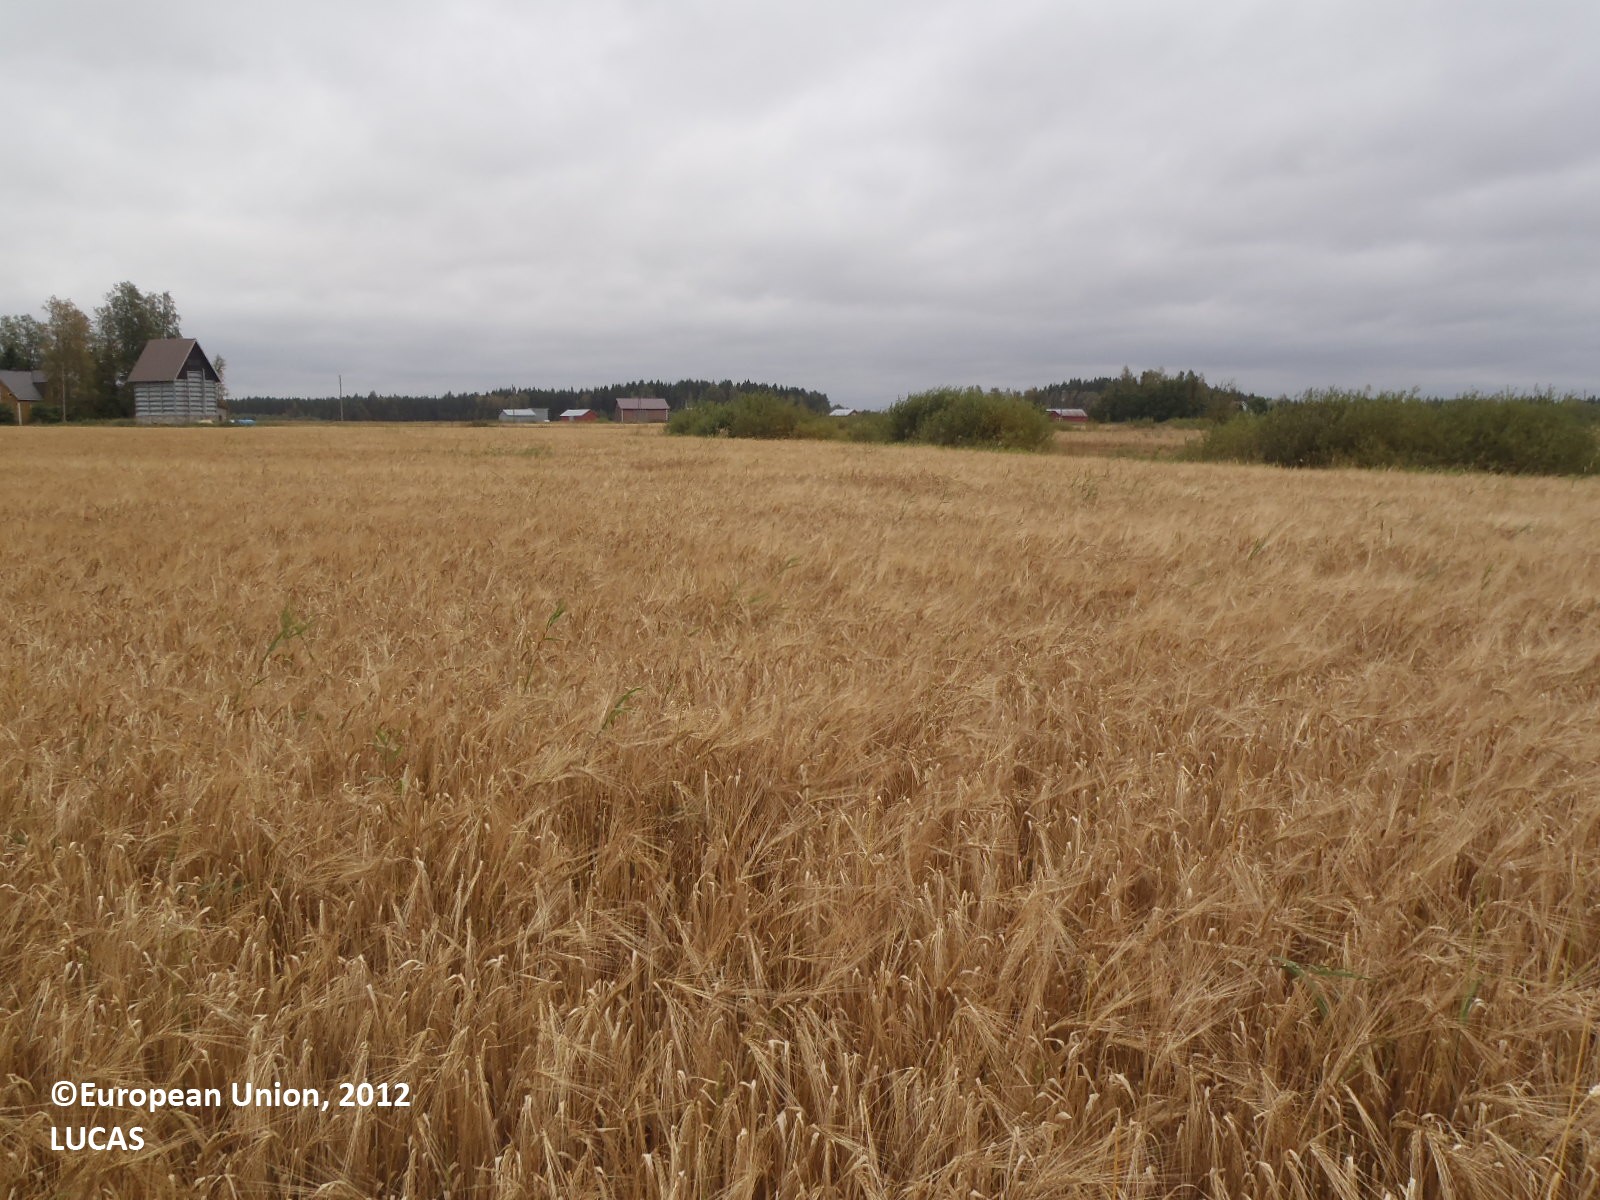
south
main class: Cropland
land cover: Barley
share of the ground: > 75 %
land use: Agriculture (excluding fallow land and kitchen gardens)
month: September
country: FI
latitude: 60.8001
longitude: 22.8072
